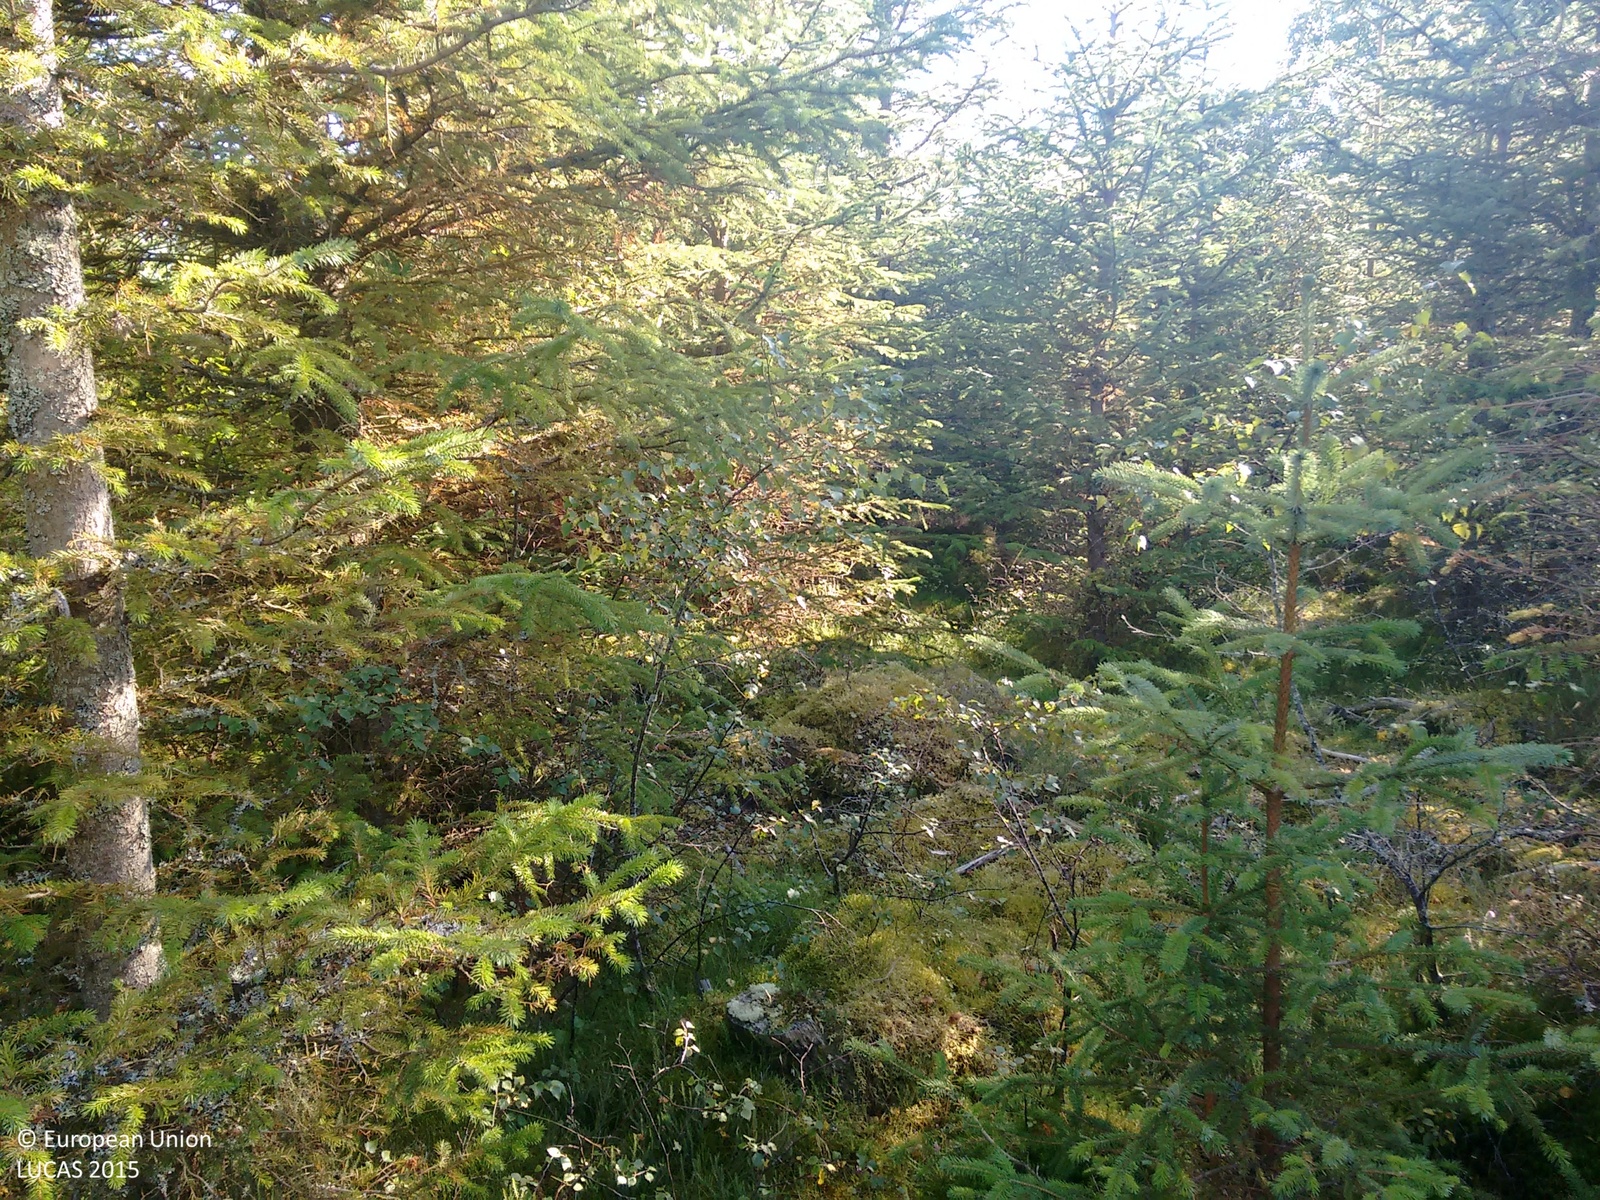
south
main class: Woodland
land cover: Spruce dominated mixed woodland
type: exotic forest
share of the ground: > 75 %
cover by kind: coniferous forest trees 65 %, broadleaved forest trees 30 %, lichens and mosses 5 %
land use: Forestry
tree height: > 5 m
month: September
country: GB
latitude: 57.4490
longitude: -3.7907
